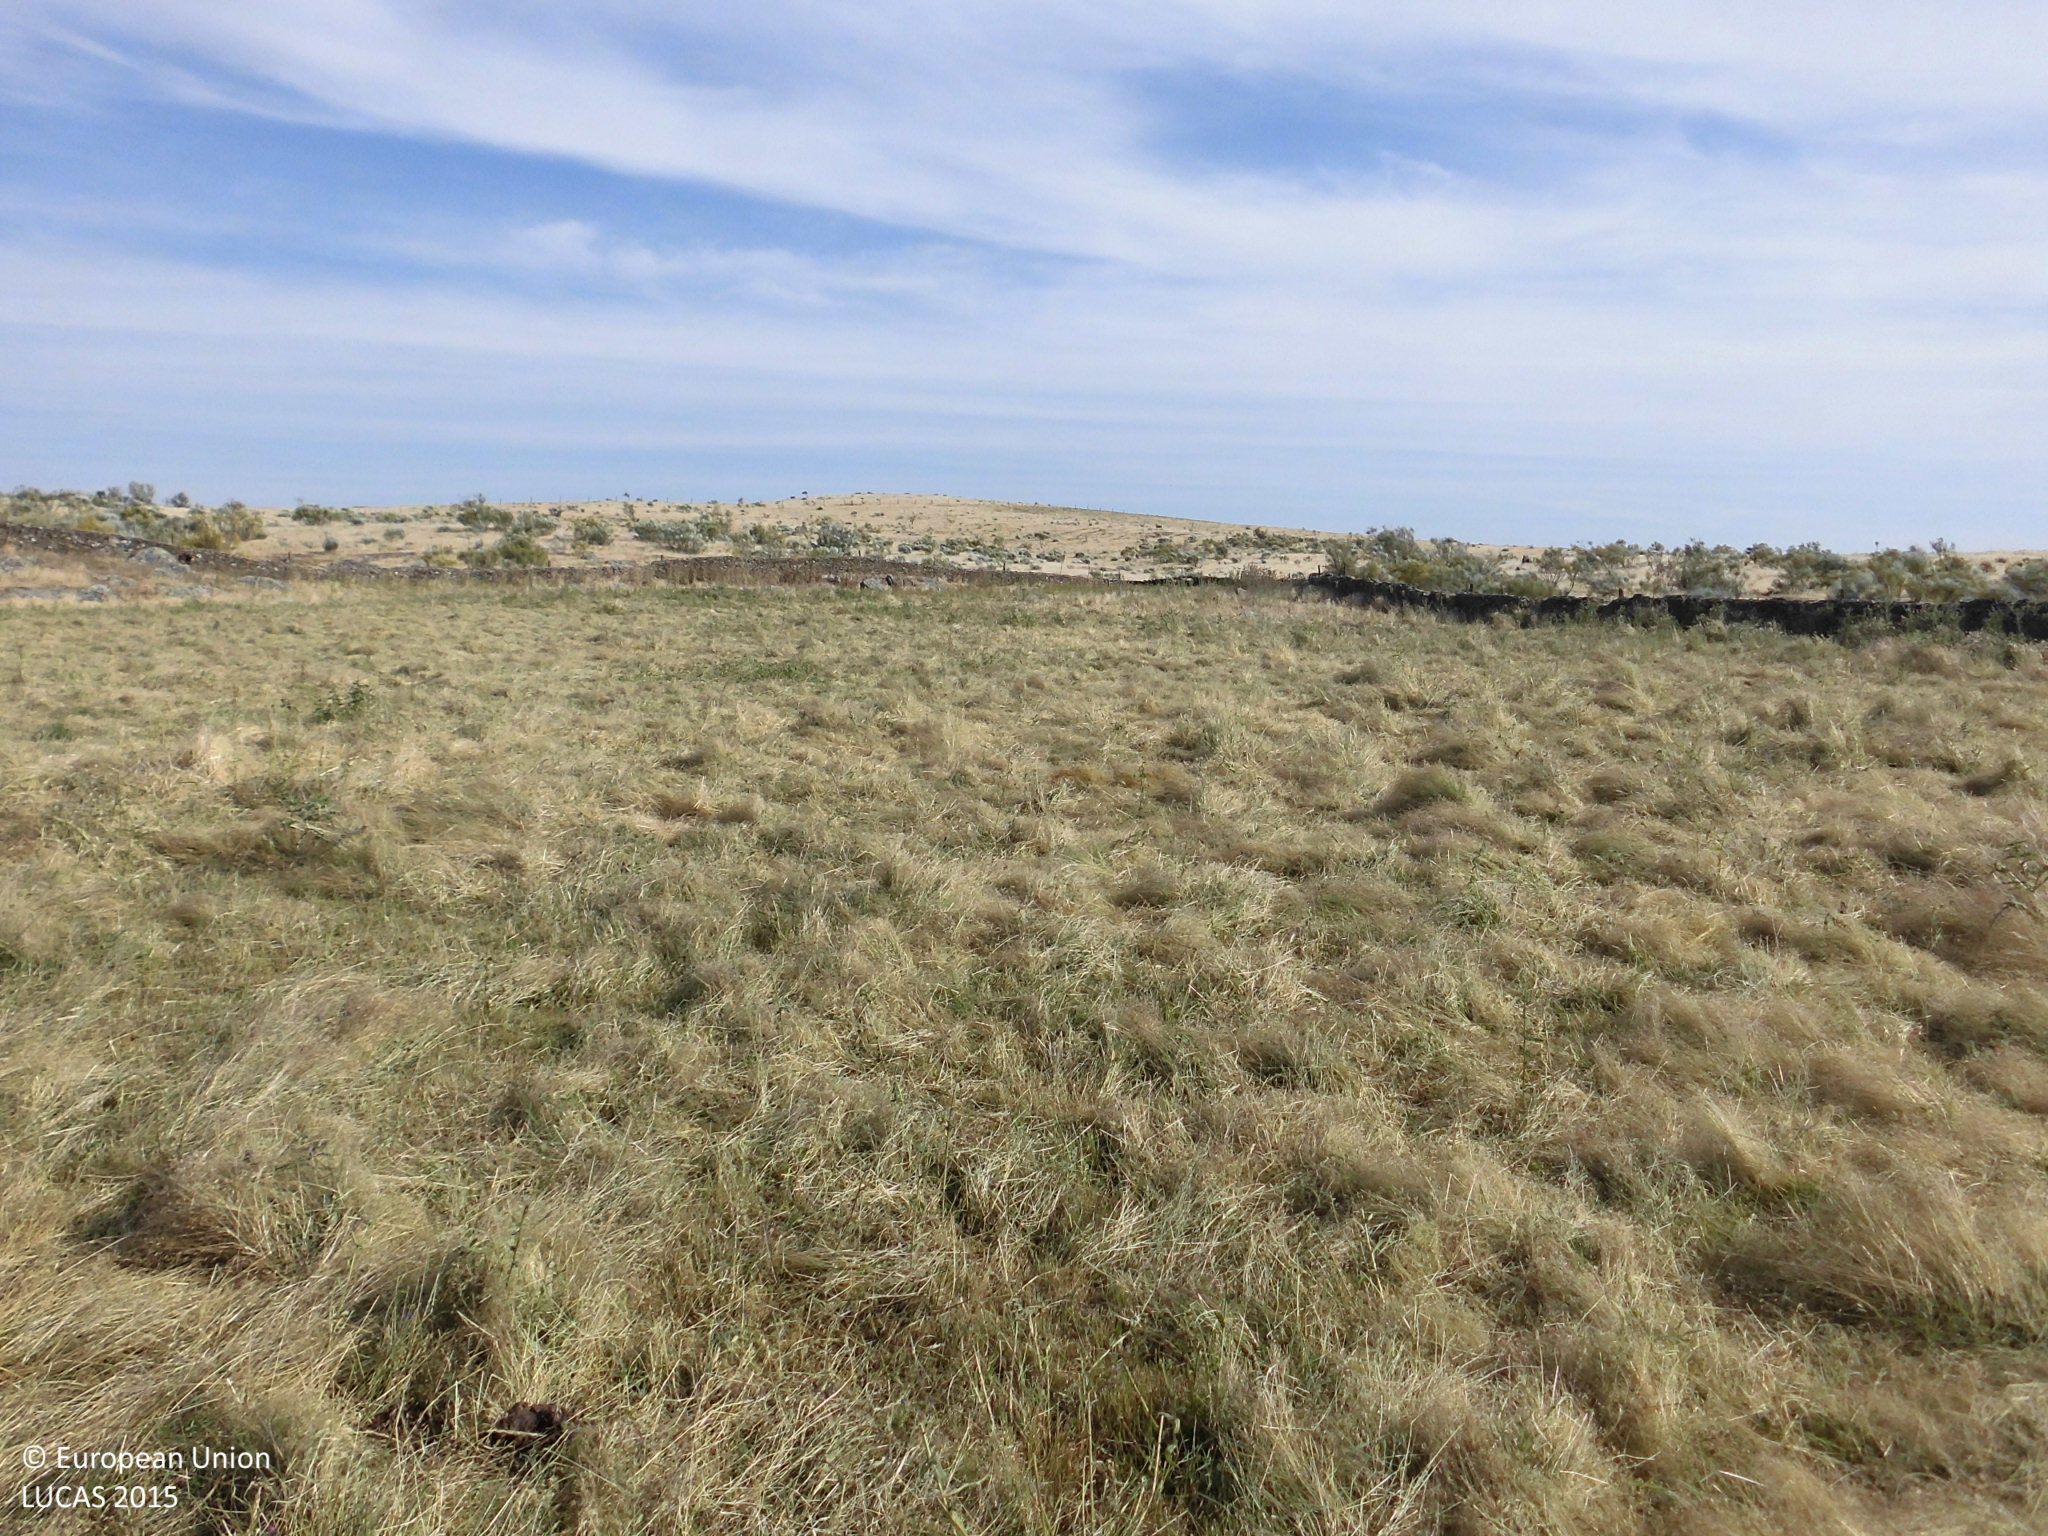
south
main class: Grassland
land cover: Grassland without tree/shrub cover
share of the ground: > 75 %
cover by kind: herbaceous plants 100 %
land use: Agriculture (excluding fallow land and kitchen gardens)
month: May
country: ES
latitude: 39.4861
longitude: -5.9535
